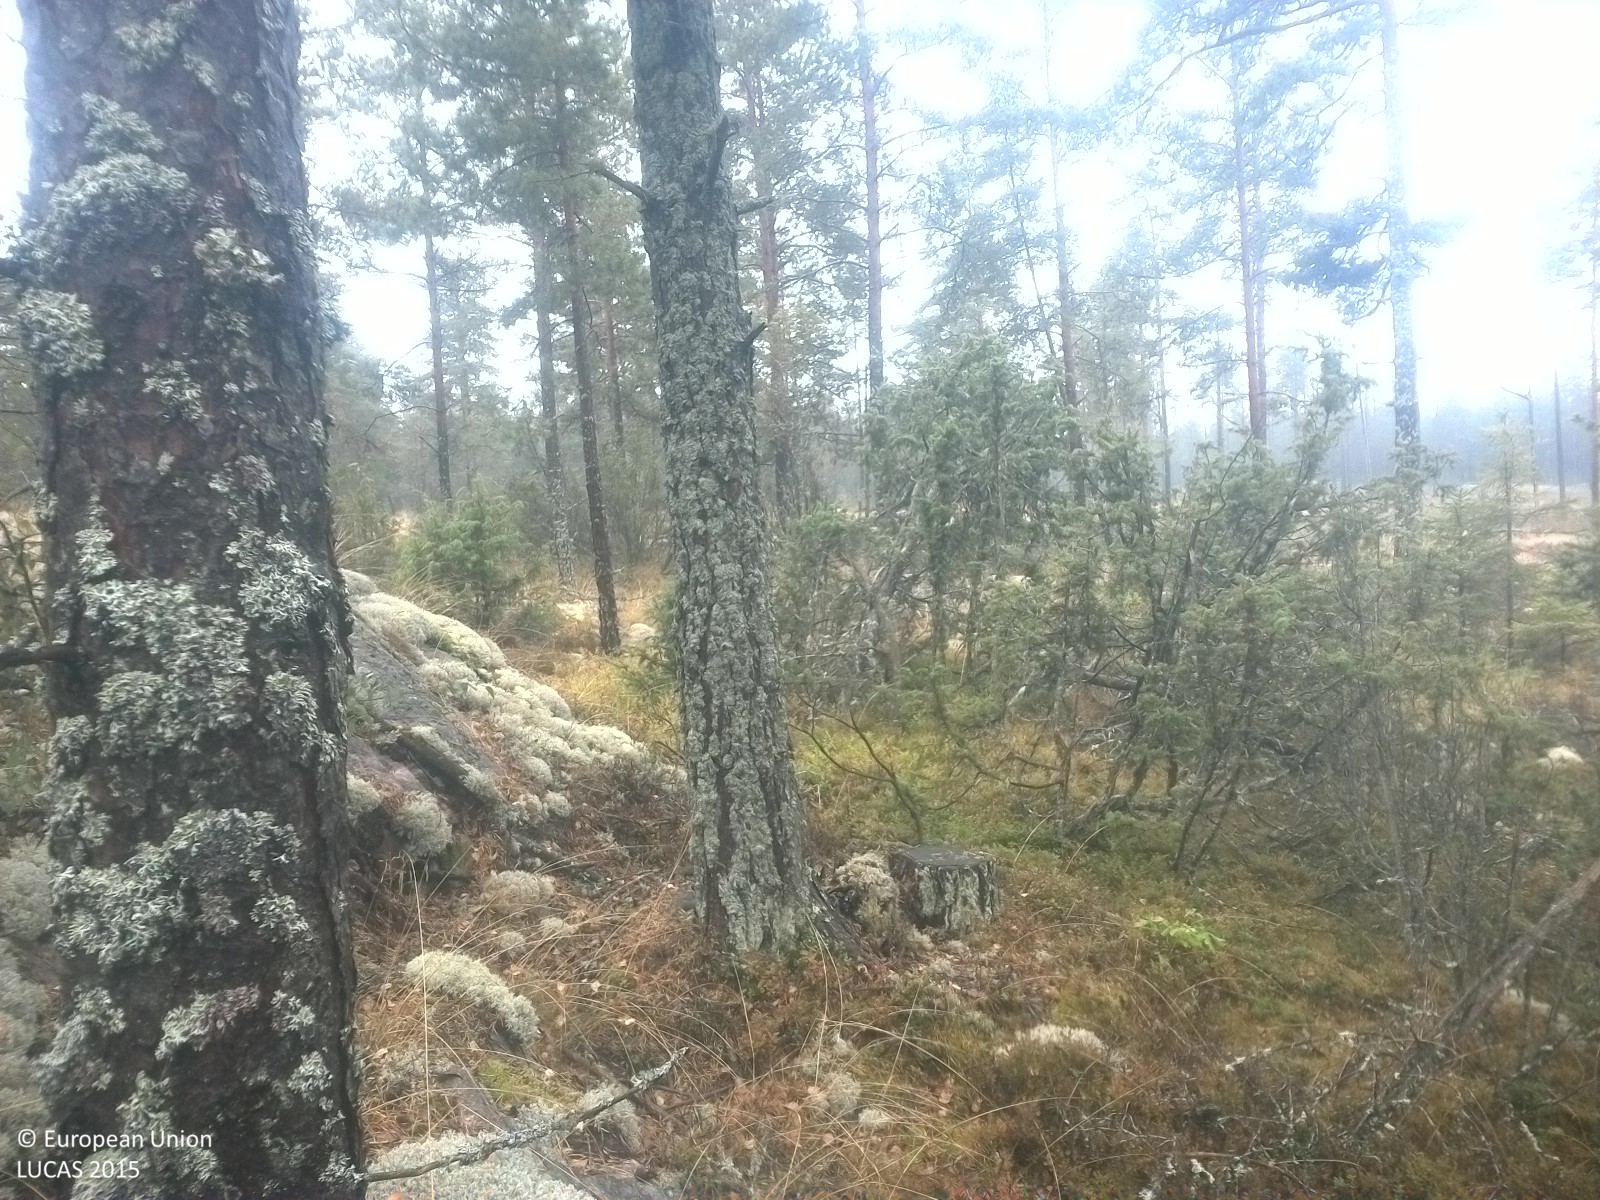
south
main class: Woodland
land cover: Pine dominated coniferous woodland
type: boreal forest
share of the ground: 10 - 25 %
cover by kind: herbaceous plants 35 %, lichens and mosses 25 %, coniferous forest trees 20 %, shrubs 20 %
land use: Forestry
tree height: > 5 m
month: September
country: SE
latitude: 58.5572
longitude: 16.7167
